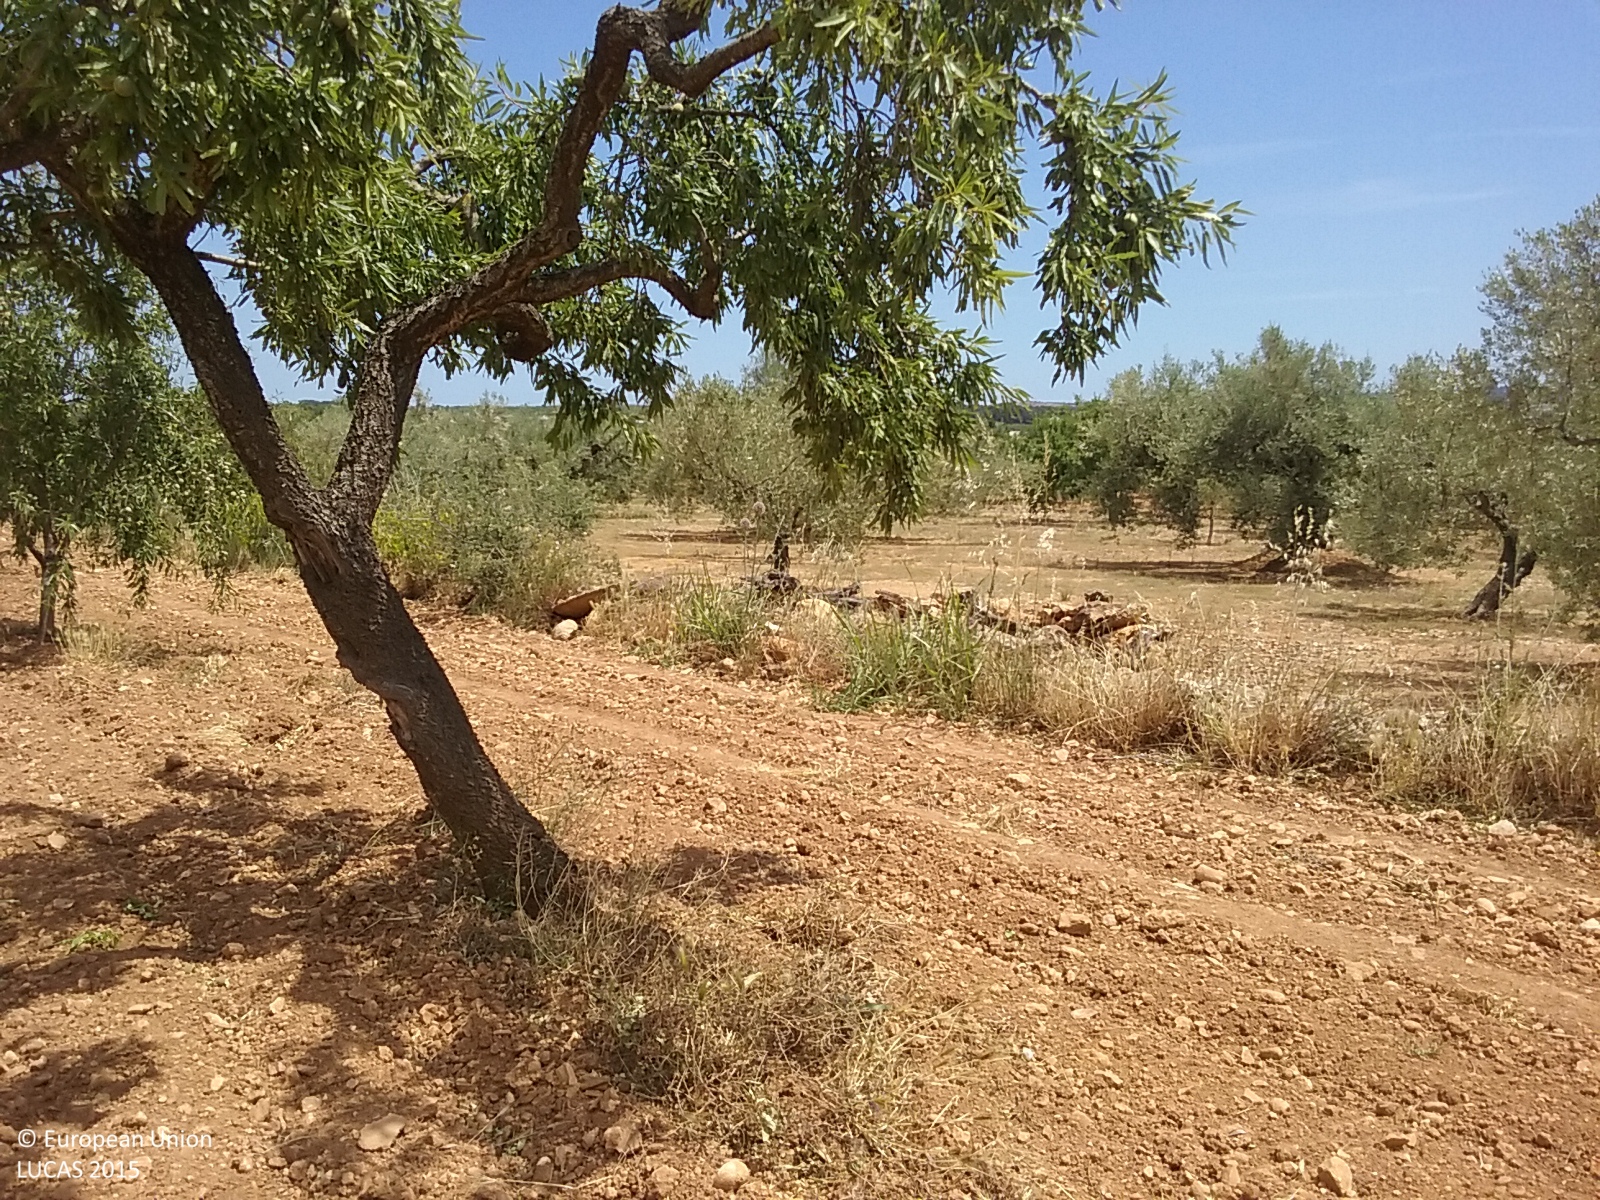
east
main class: Cropland
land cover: Nuts trees
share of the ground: 10 - 25 %
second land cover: Other bare soil
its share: > 75 %
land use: Agriculture (excluding fallow land and kitchen gardens)
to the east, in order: Nuts trees; Other bare soil; Grass margins; Dry stone walls; Olive groves; Dry stone walls; Paved roads, cycling and walking lanes; Grass margins; Nuts trees; Dry stone walls; Grass margins; Nuts trees
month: May
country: ES
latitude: 40.2307
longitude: 0.0187
